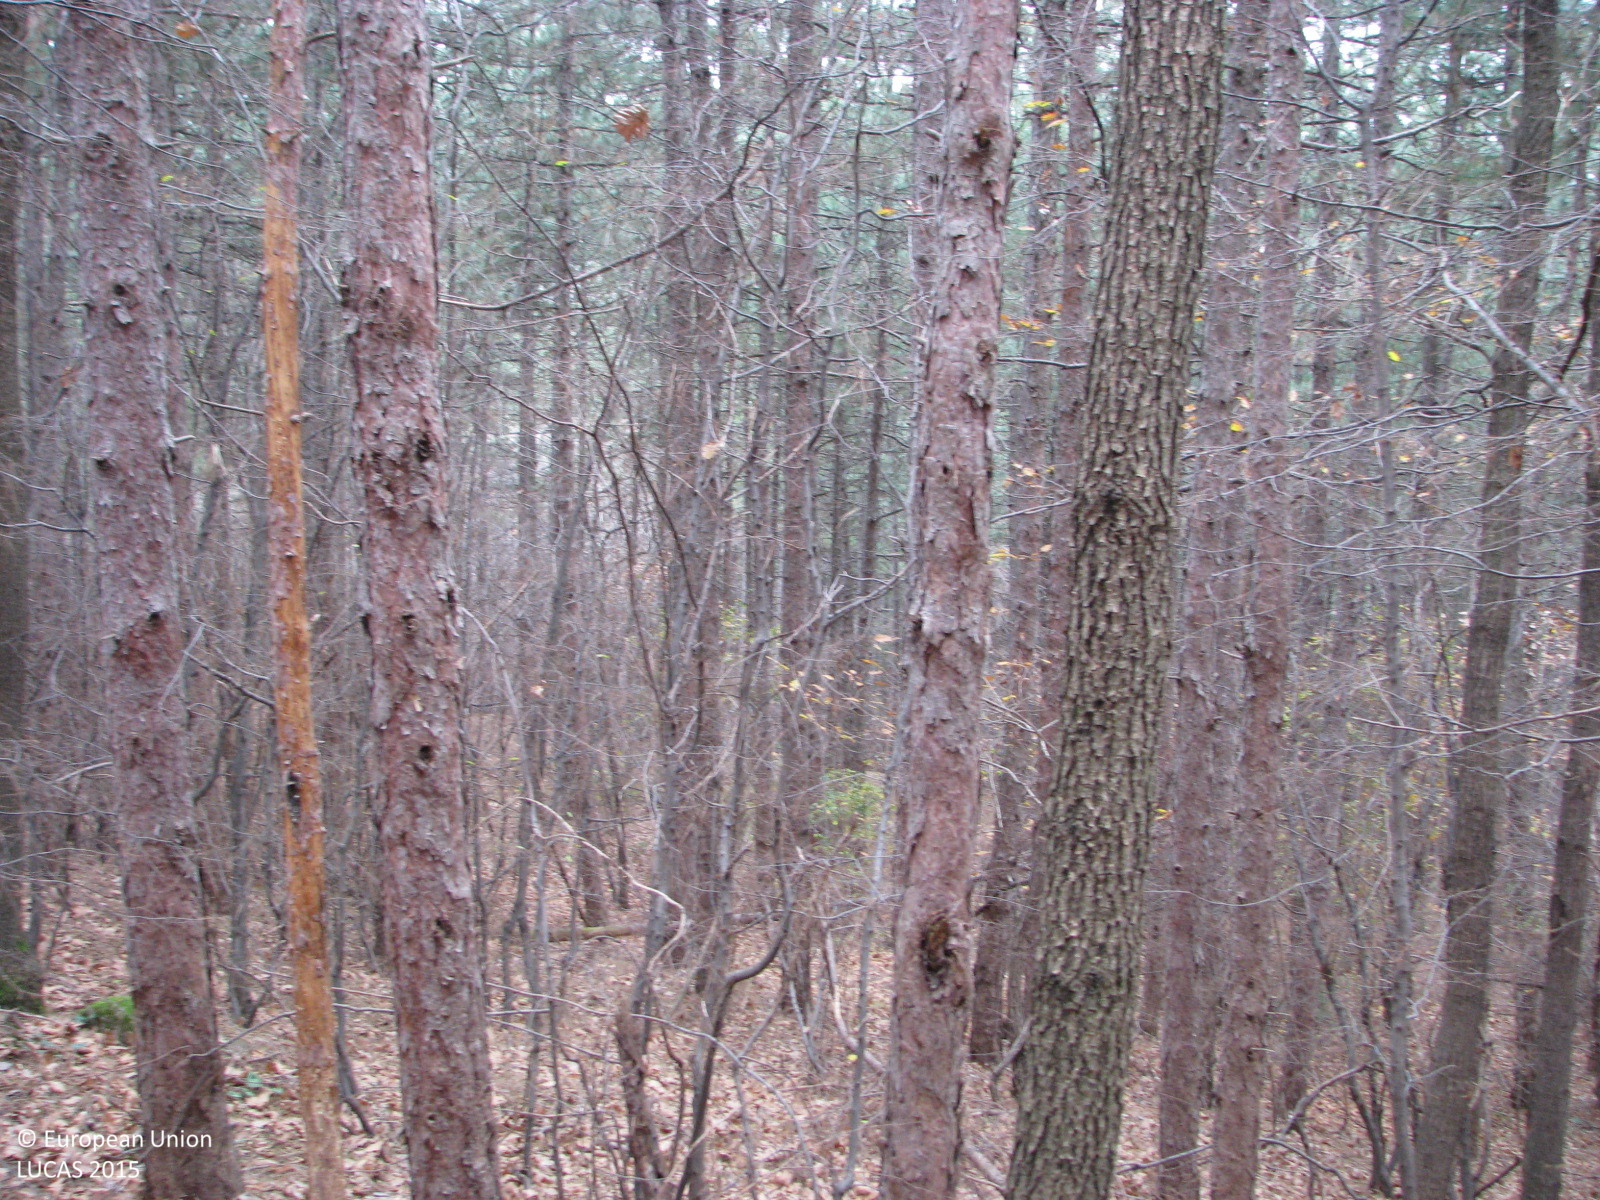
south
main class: Woodland
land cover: Pine dominated mixed woodland
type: hemiboreal forest and nemoral coniferous forest and mixed broadleaved-coniferous forest
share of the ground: > 75 %
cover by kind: coniferous forest trees 60 %, broadleaved forest trees 30 %, unconsolidated bare surface 10 %
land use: Forestry
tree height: > 5 m
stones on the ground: < 10 %
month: December
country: BG
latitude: 42.2949
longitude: 24.0255
